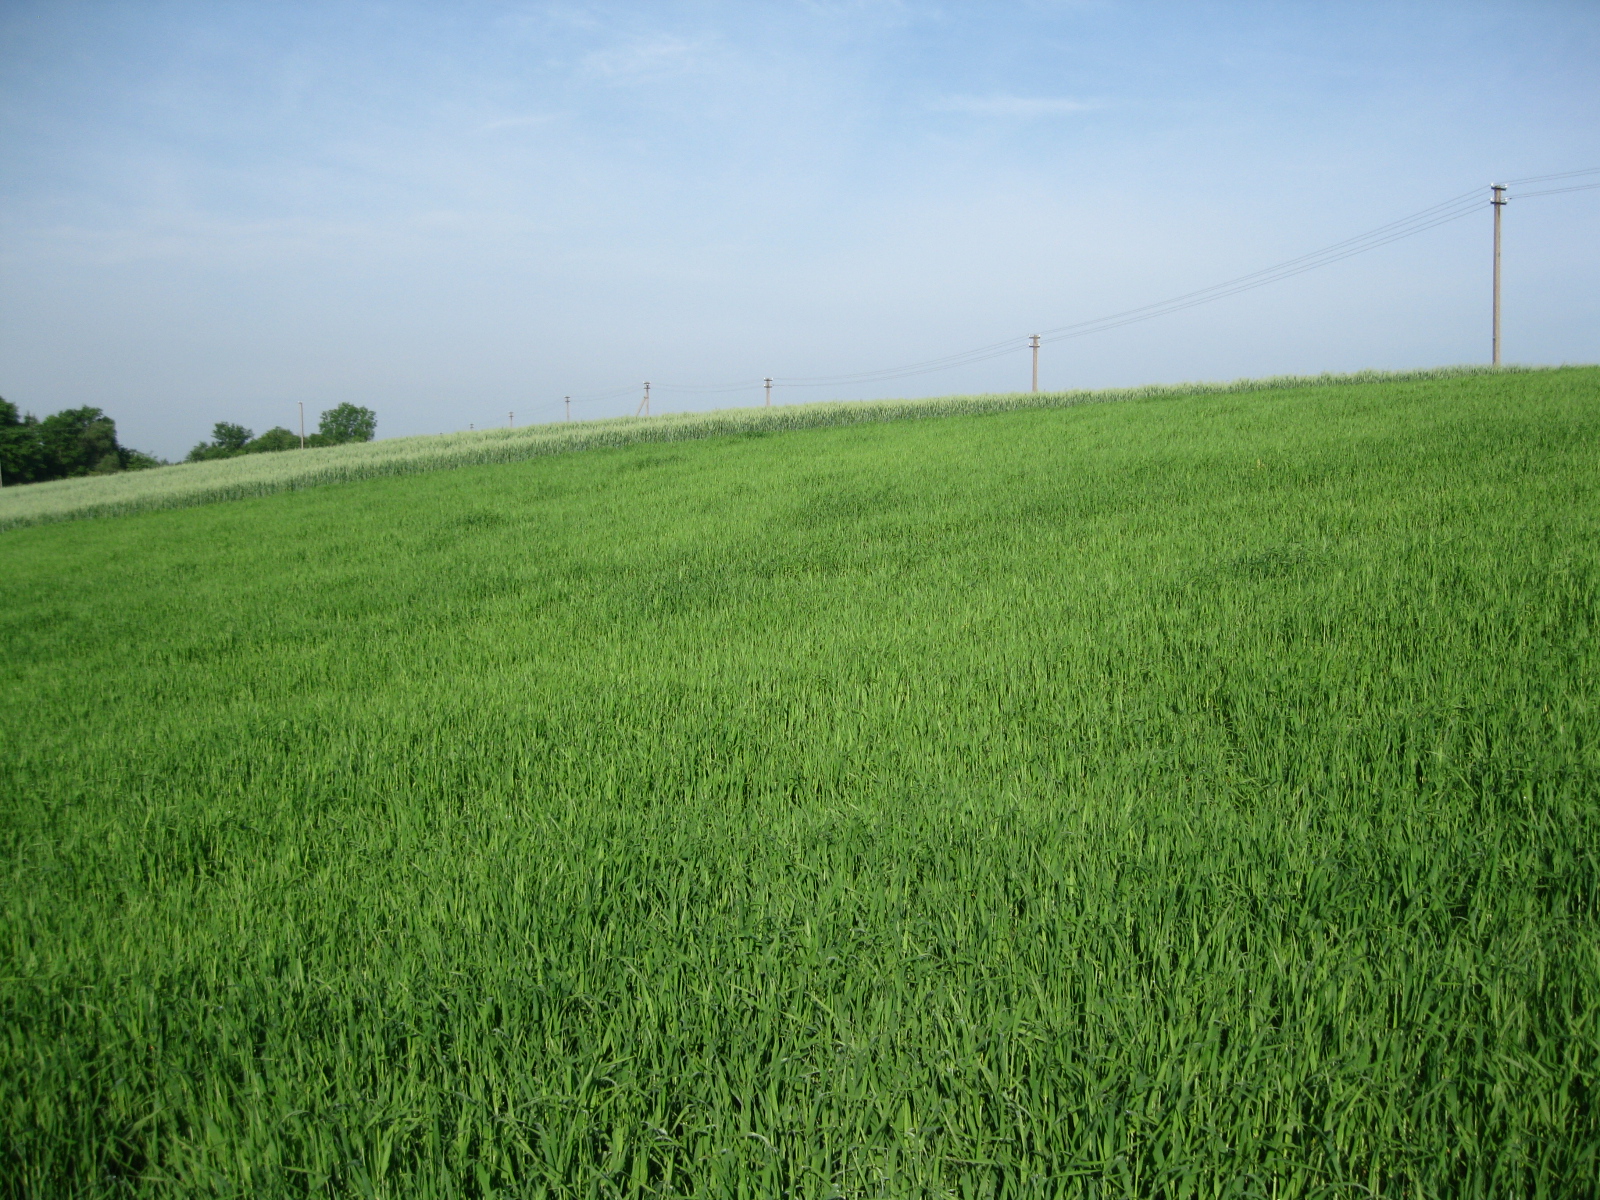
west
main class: Cropland
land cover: Barley
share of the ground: > 75 %
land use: Agriculture (excluding fallow land and kitchen gardens)
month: June
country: LT
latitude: 55.4169
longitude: 23.6523
